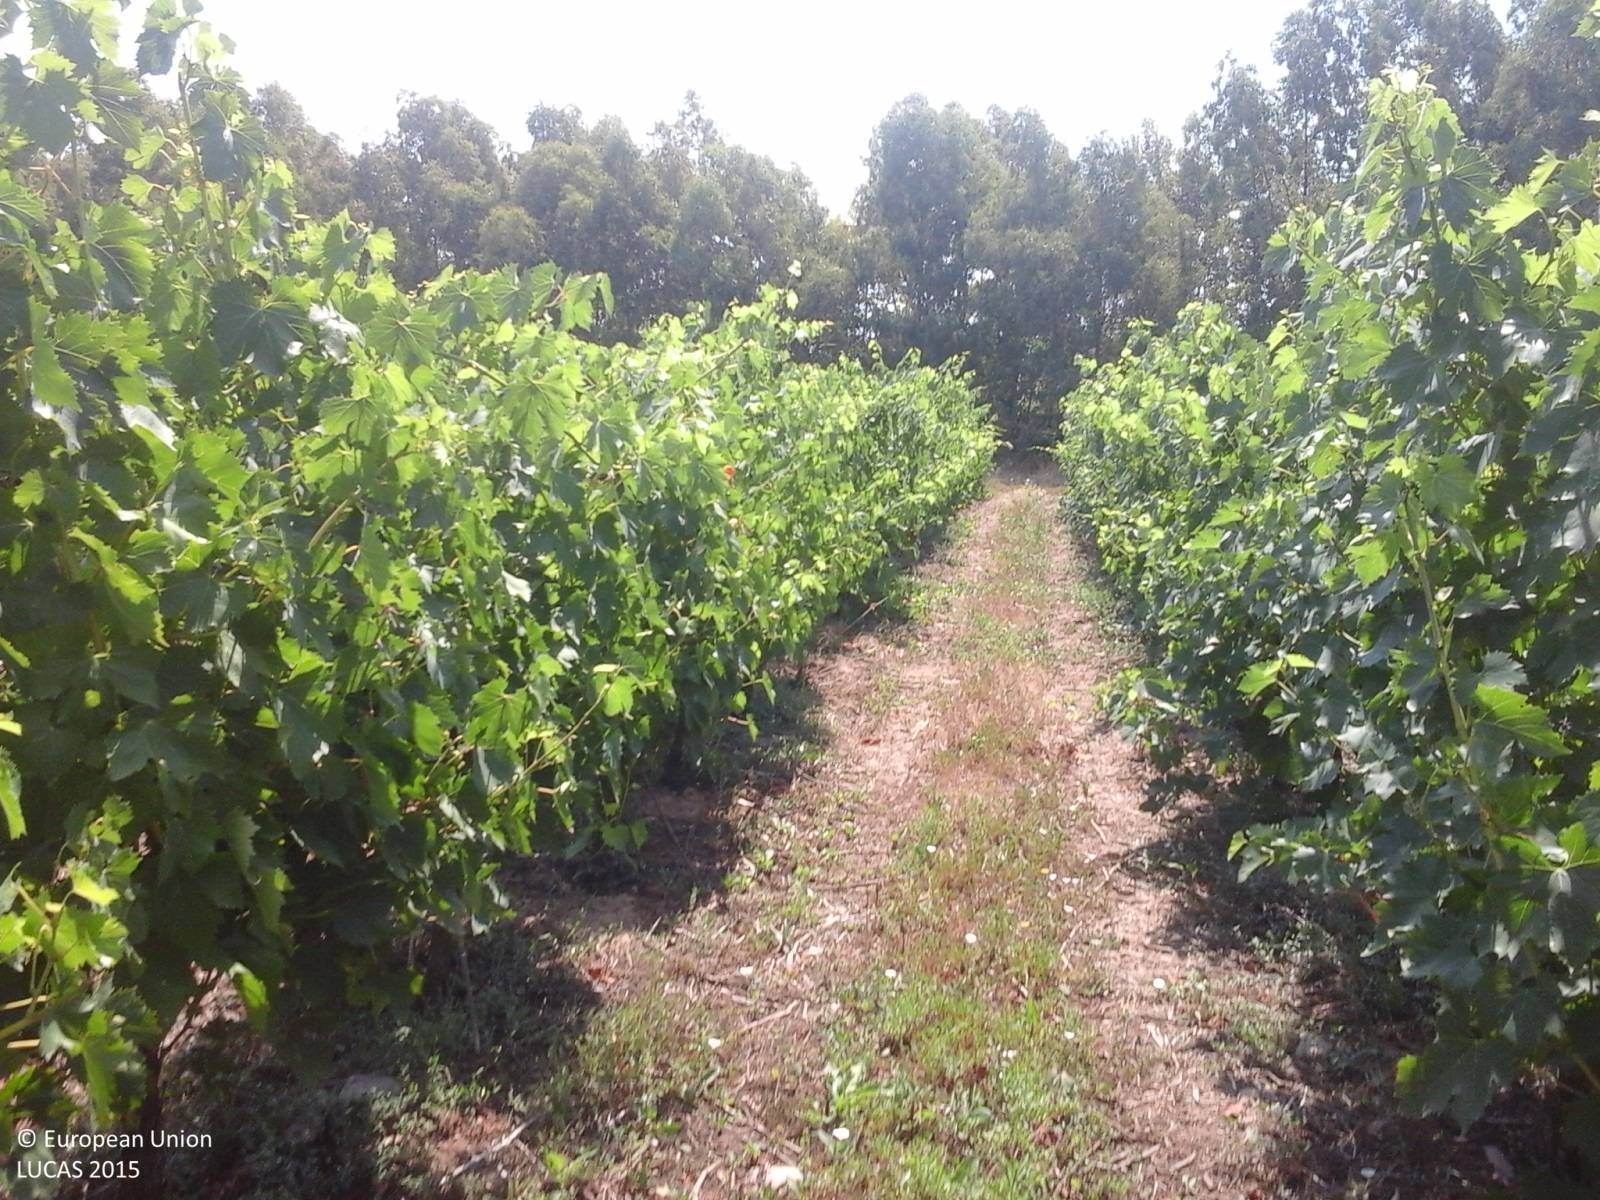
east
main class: Cropland
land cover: Vineyards
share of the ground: 25 - 50 %
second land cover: Spontaneously vegetated surfaces
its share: 50 - 75 %
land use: Agriculture (excluding fallow land and kitchen gardens)
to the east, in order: Vineyards; Spontaneously vegetated surfaces; Tracks; Grass margins; Broadleaved woodland; Fences; Tracks; Grass margins; Fences; Other fruit trees and berries; Spontaneously vegetated surfaces
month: July
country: IT
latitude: 39.2974
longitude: 8.6055
